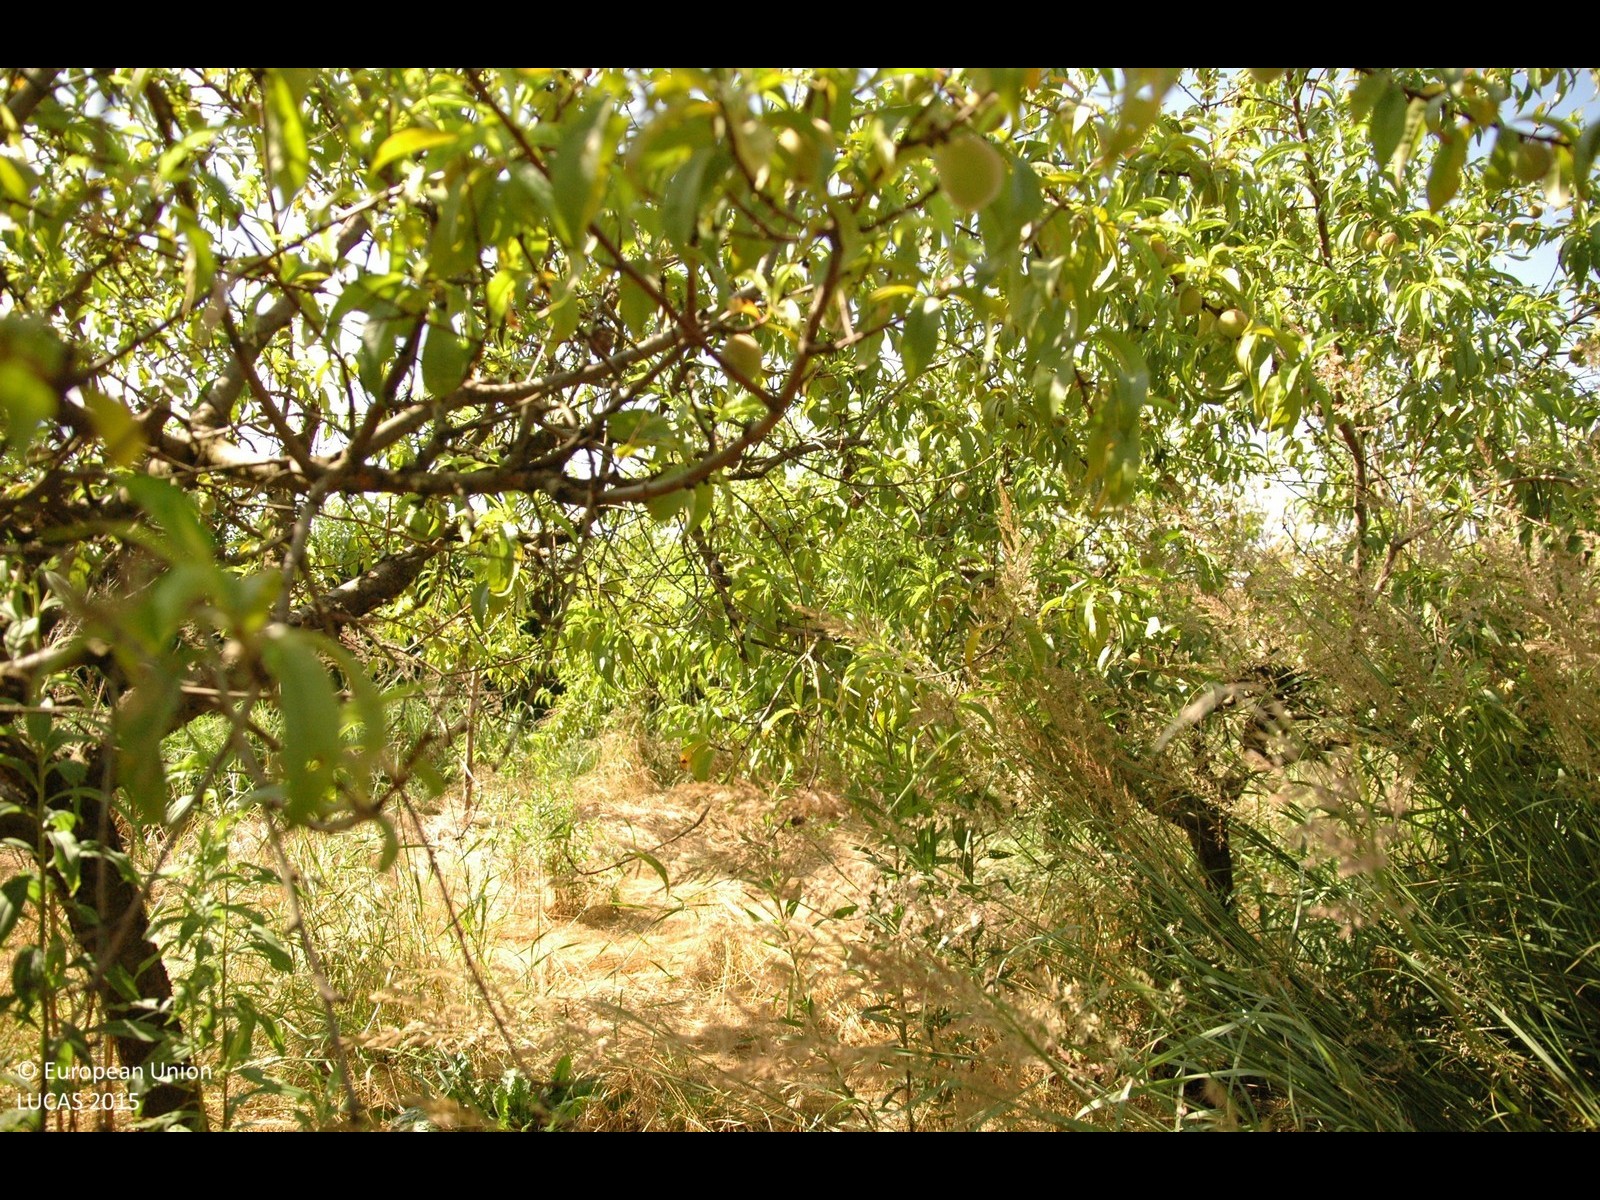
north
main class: Cropland
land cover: Other fruit trees and berries
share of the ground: > 75 %
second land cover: Grassland without tree/shrub cover
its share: 10 - 25 %
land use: Agriculture (excluding fallow land and kitchen gardens)
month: June
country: HR
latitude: 46.4364
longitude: 16.5999
